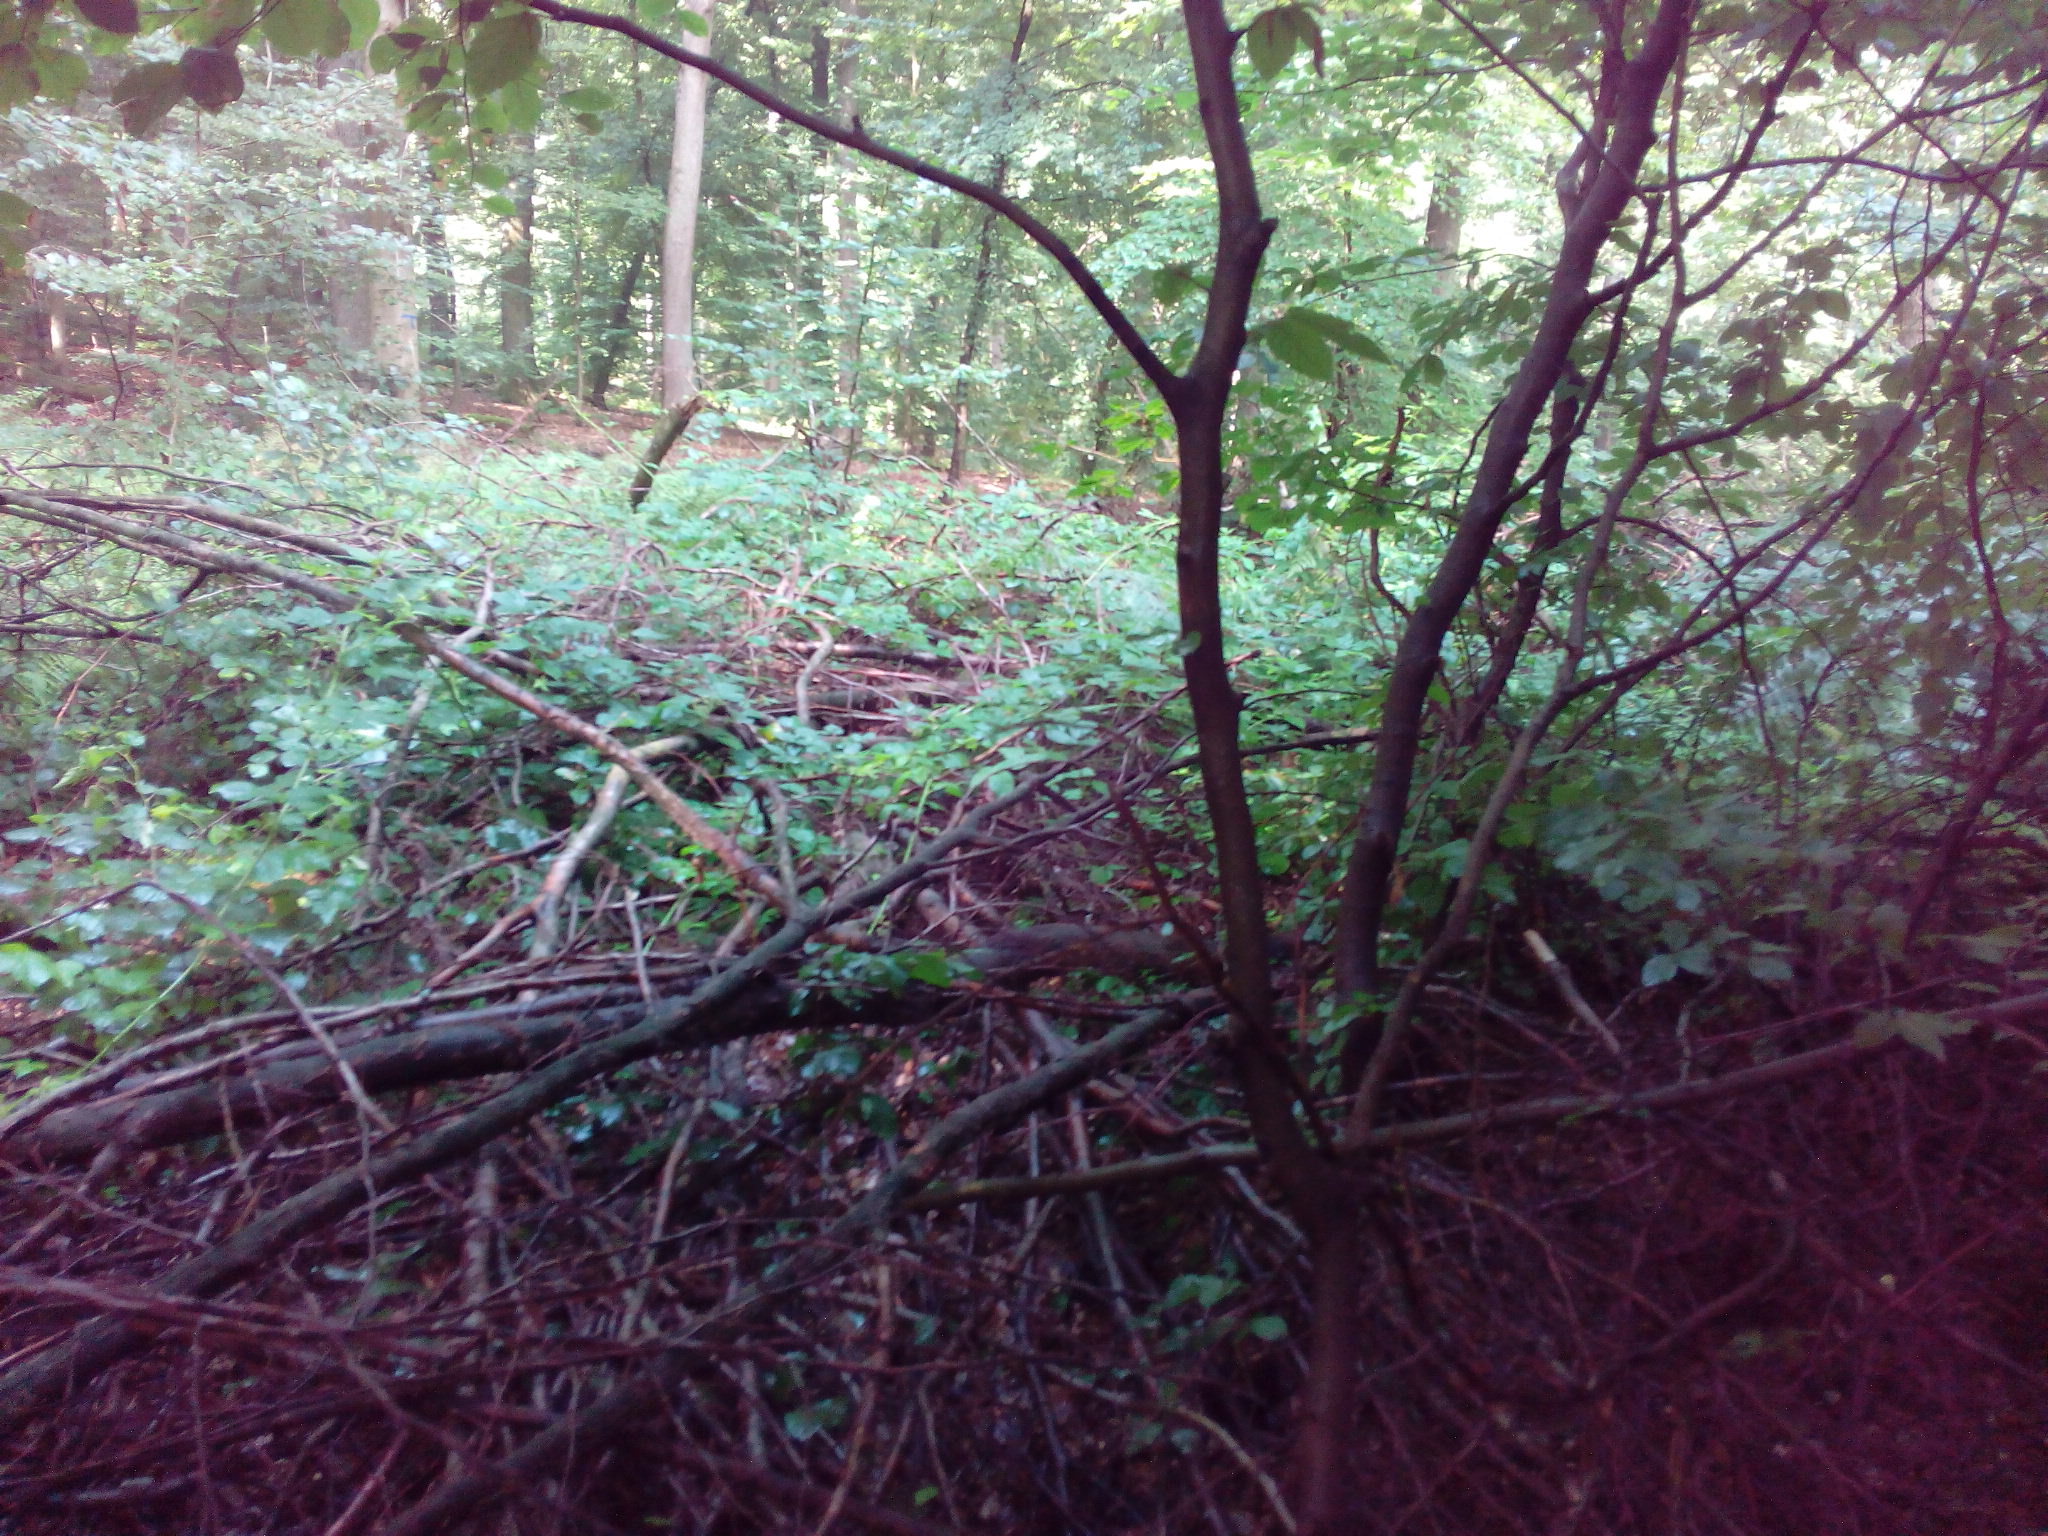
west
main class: Woodland
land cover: Broadleaved woodland
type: mesophytic deciduous forest
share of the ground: > 75 %
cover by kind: broadleaved forest trees 90 %, herbaceous plants 10 %
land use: Forestry
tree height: > 5 m
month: August
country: DE
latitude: 52.1078
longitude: 9.8978
